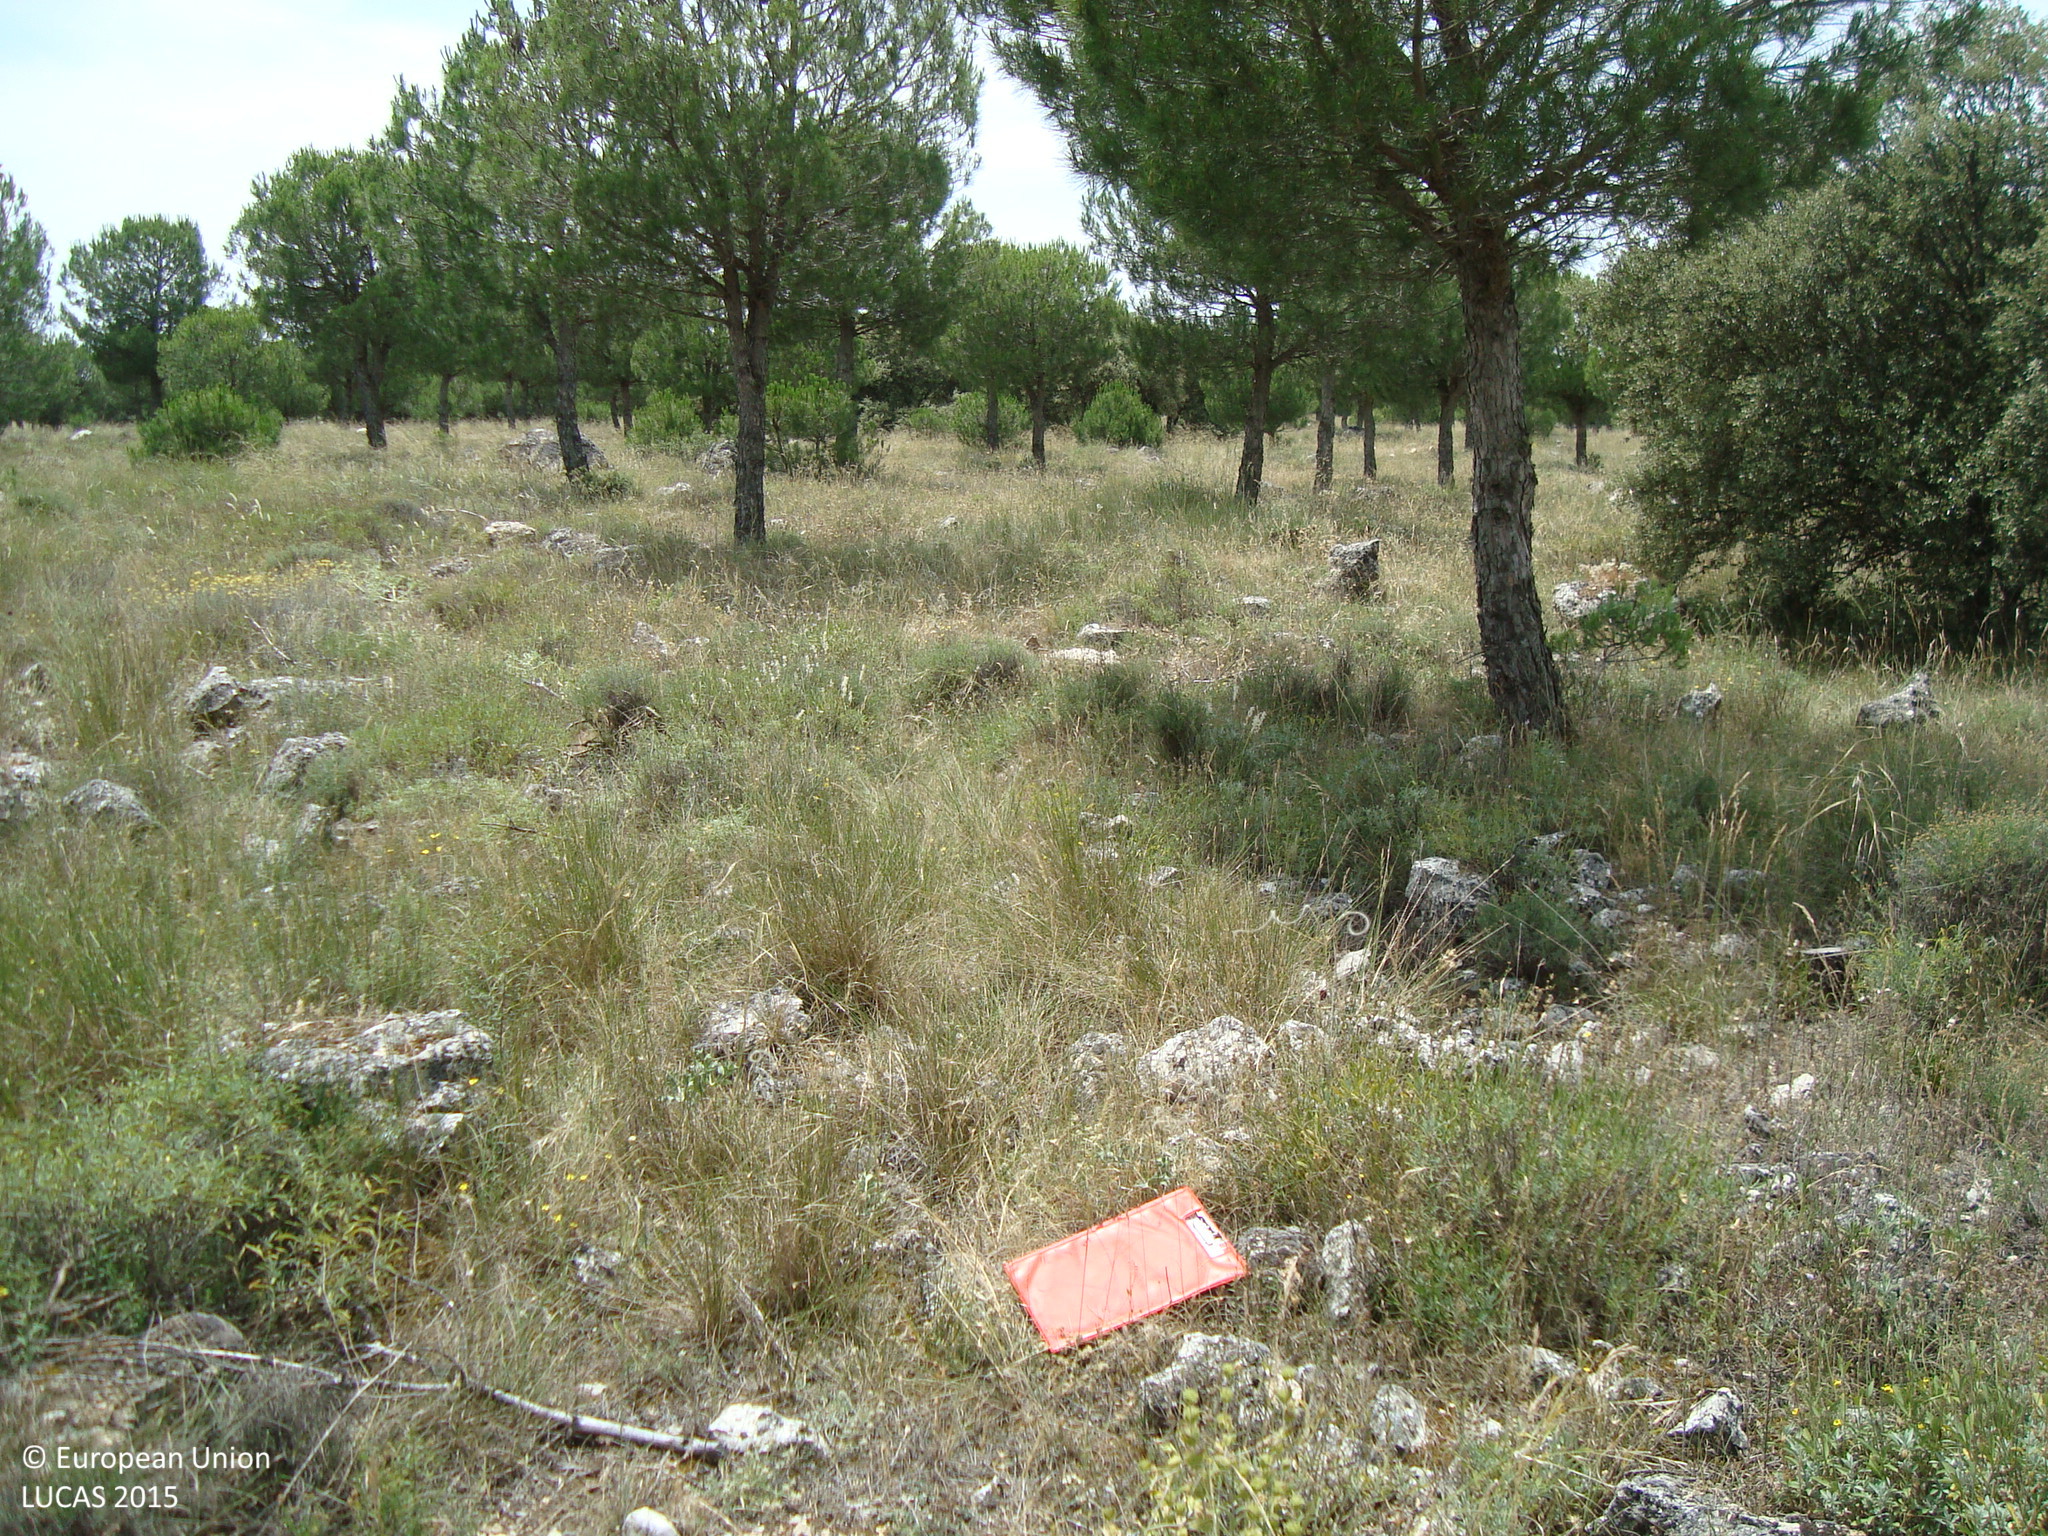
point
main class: Woodland
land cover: Pine dominated coniferous woodland
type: coniferous forest of the mediterranean region
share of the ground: 10 - 25 %
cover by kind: shrubs 60 %, coniferous forest trees 20 %, herbaceous plants 10 %, broadleaved forest trees 5 %, unconsolidated bare surface 5 %
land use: Forestry
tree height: > 5 m
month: July
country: ES
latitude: 41.8041
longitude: -4.1311
